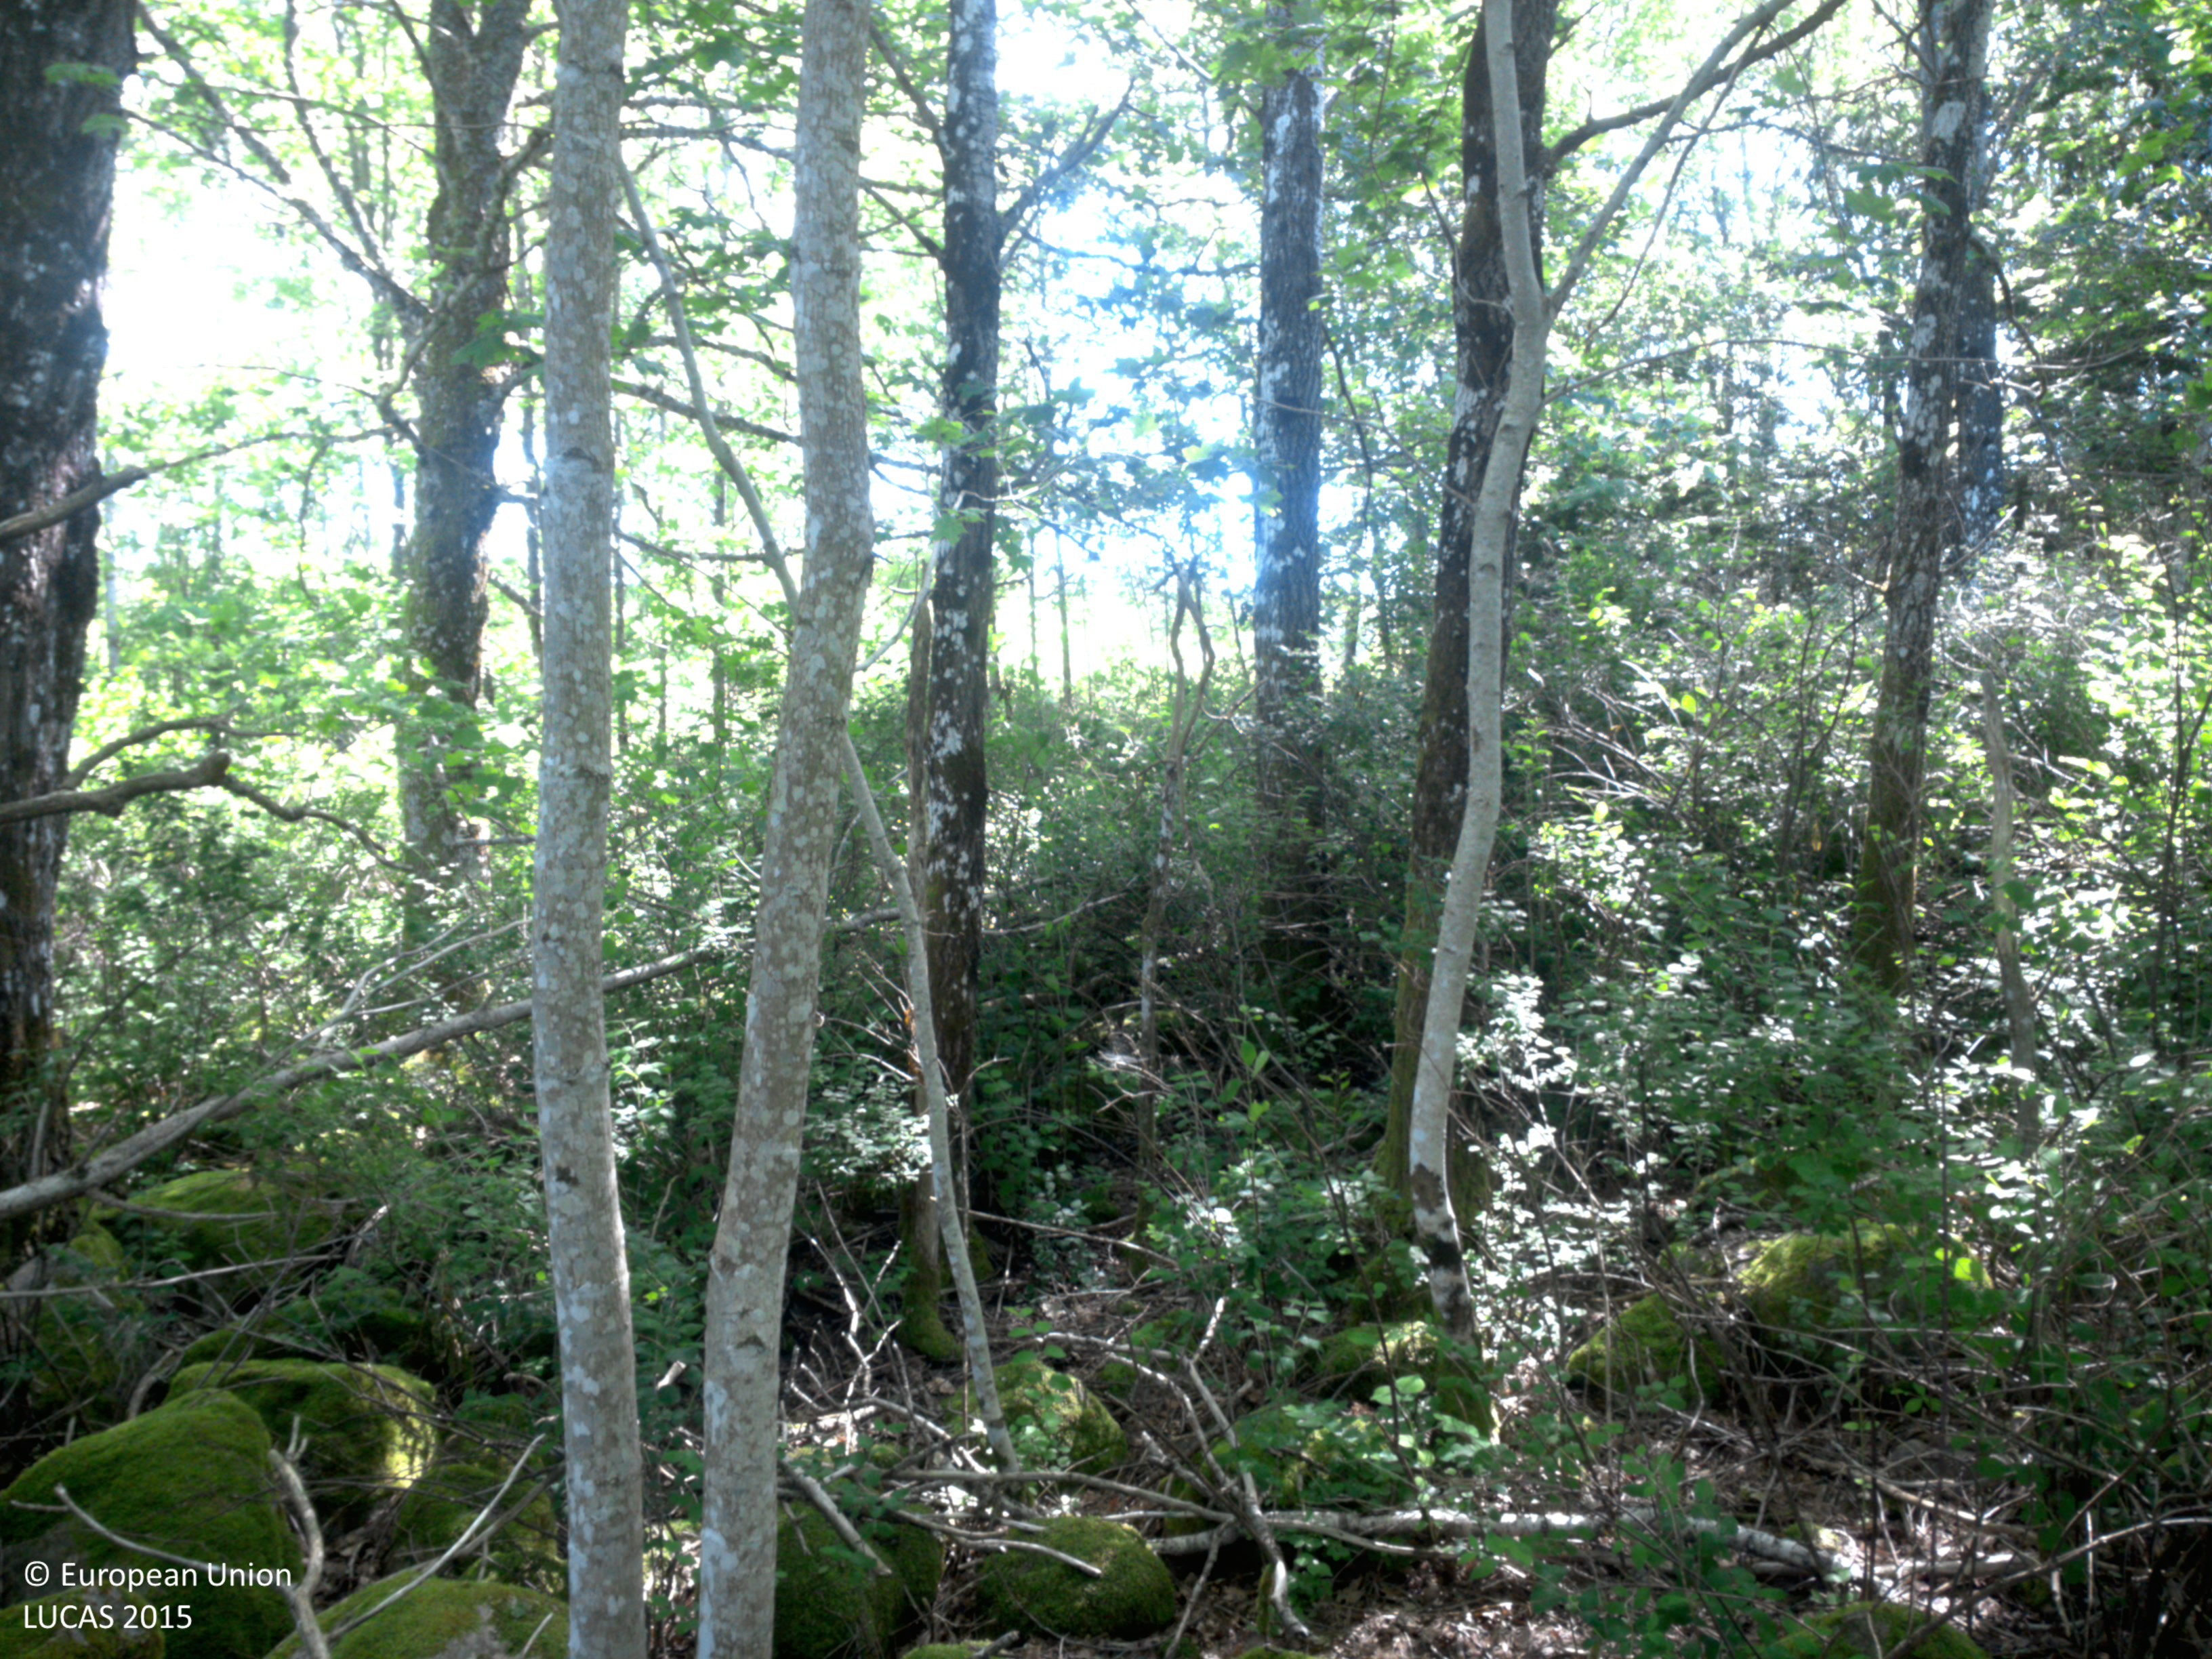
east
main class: Woodland
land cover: Broadleaved woodland
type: hemiboreal forest and nemoral coniferous forest and mixed broadleaved-coniferous forest
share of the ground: > 75 %
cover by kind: broadleaved forest trees 75 %, shrubs 15 %, herbaceous plants 10 %
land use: Semi-natural and natural areas not in use
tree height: > 5 m
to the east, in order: Broadleaved woodland; Electric lines; Ditches and canals; Grass margins; Triticale
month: June
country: SE
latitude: 58.4971
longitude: 11.6608
